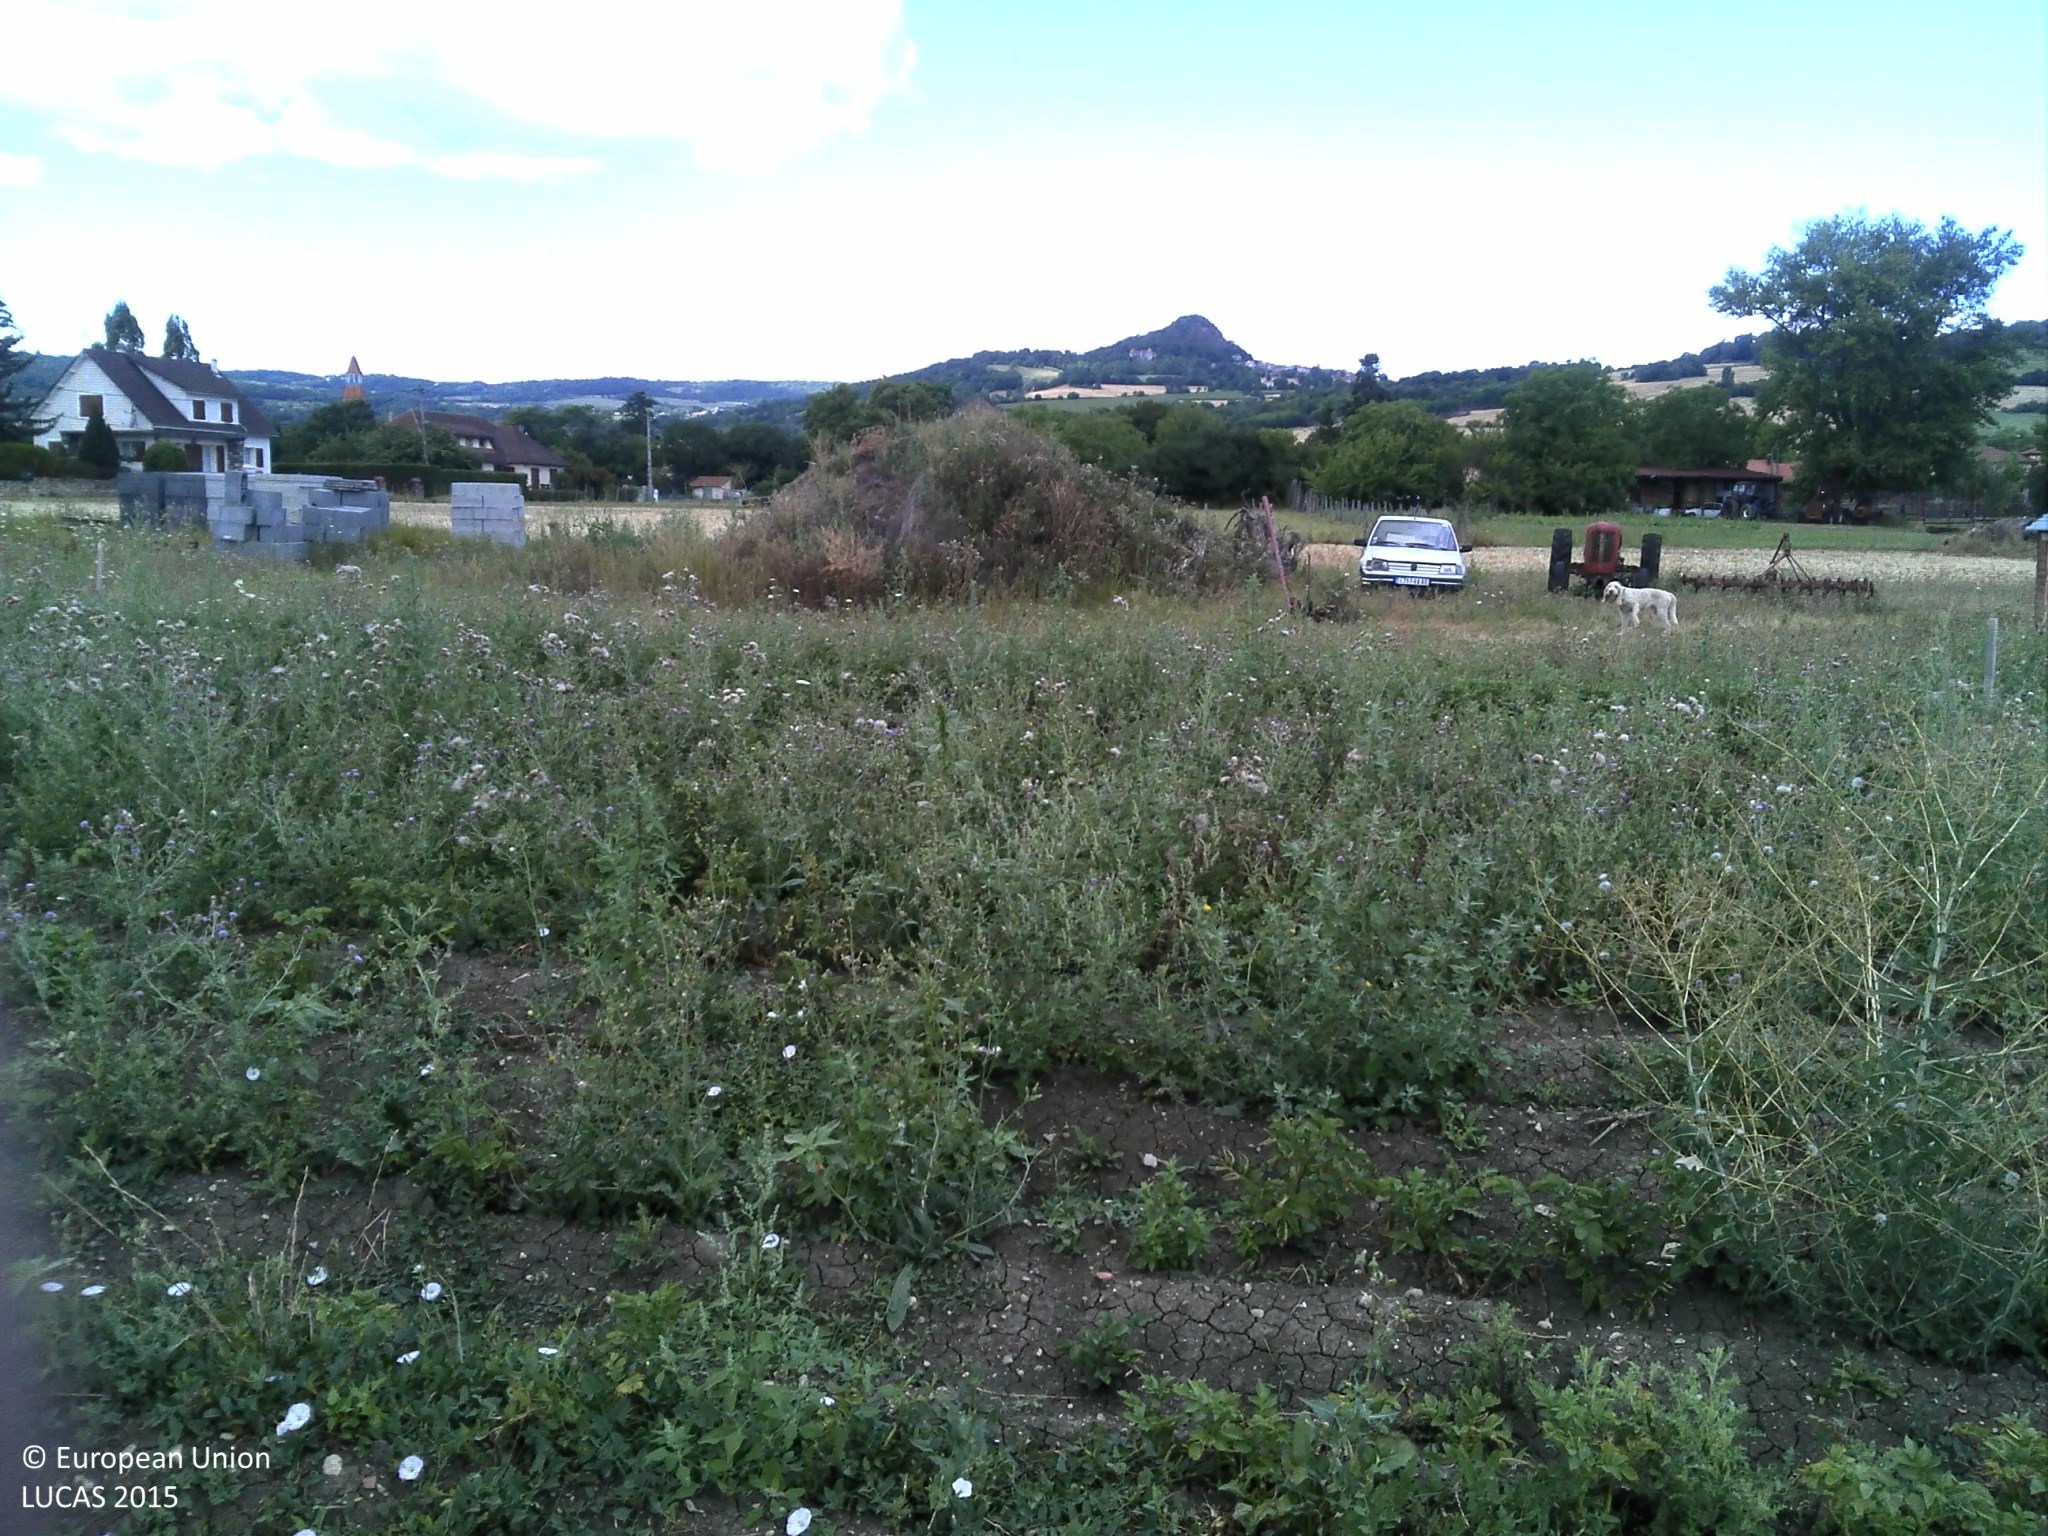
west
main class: Cropland
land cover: Potatoes
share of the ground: < 10 %
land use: Kitchen garden
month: July
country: FR
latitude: 45.5007
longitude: 3.1797
